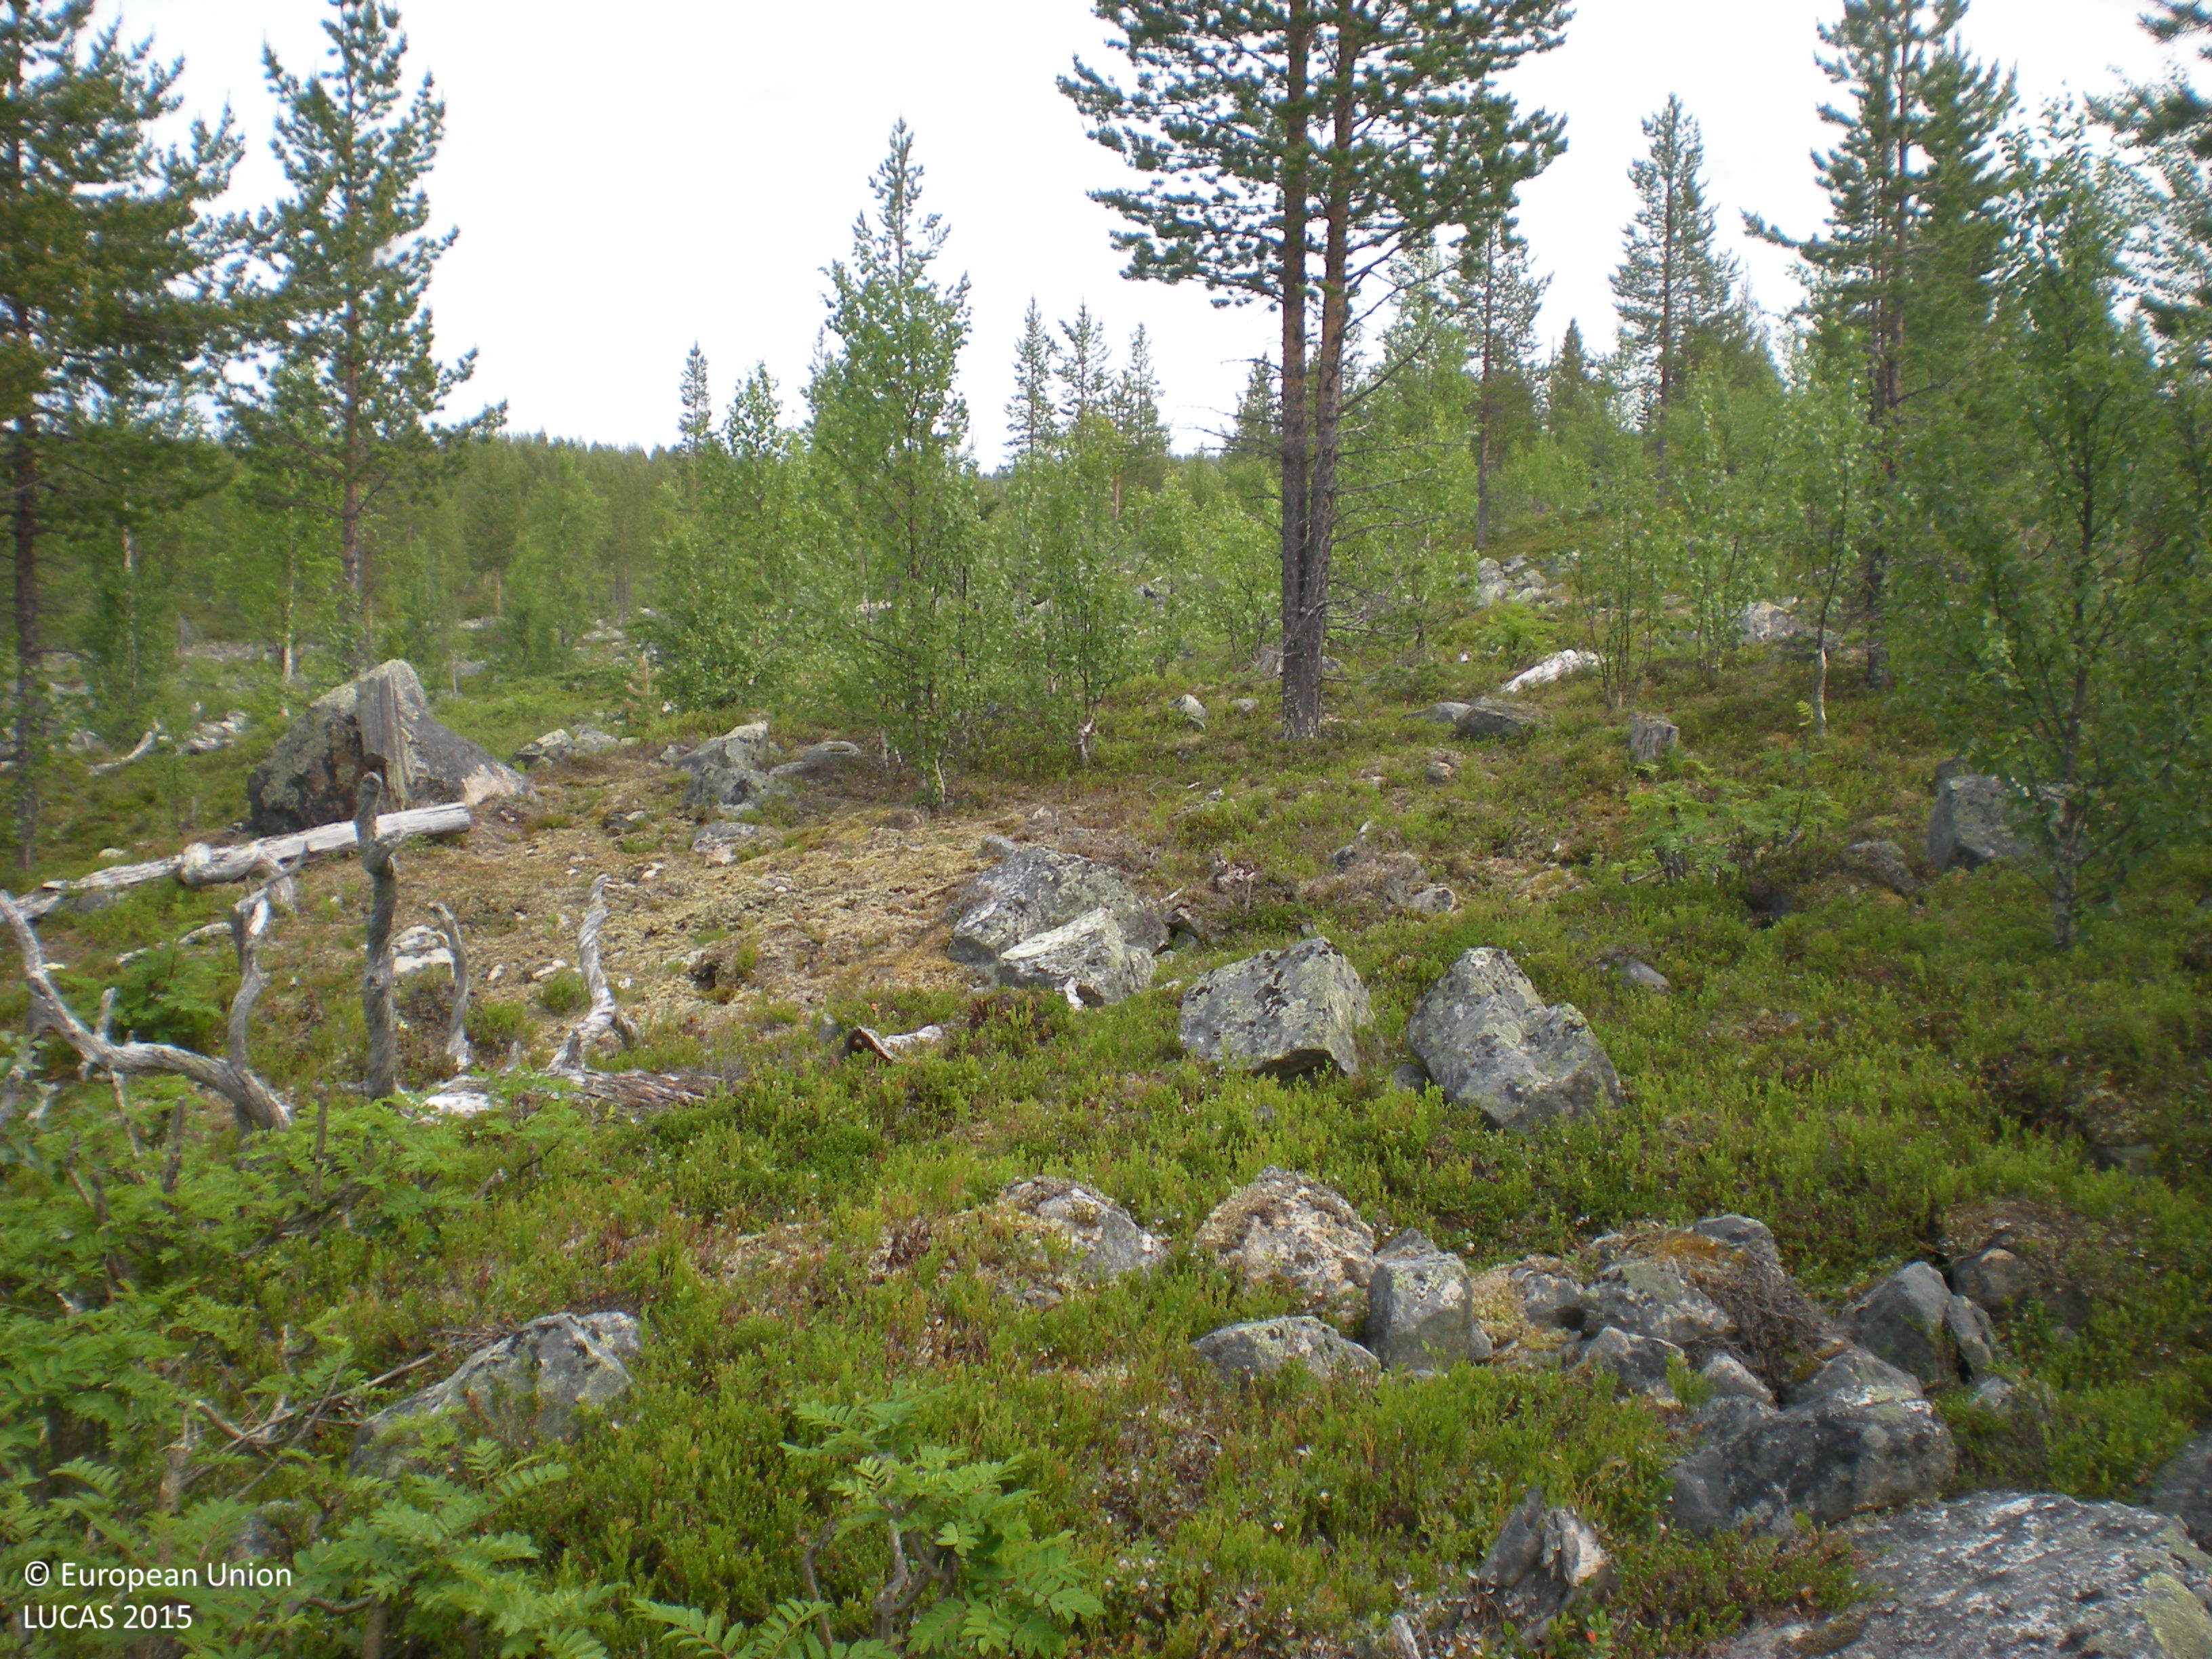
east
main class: Woodland
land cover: Spruce dominated mixed woodland
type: boreal forest
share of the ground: 25 - 50 %
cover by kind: shrubs 40 %, coniferous forest trees 25 %, broadleaved forest trees 20 %, consolidated bare surface 10 %, lichens and mosses 5 %
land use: Forestry
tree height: > 5 m
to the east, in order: Spruce dominated mixed woodland; Rocks and stones; Inland fresh running water; Sand; Inland marshes
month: July
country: SE
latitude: 65.5951
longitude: 17.2256
